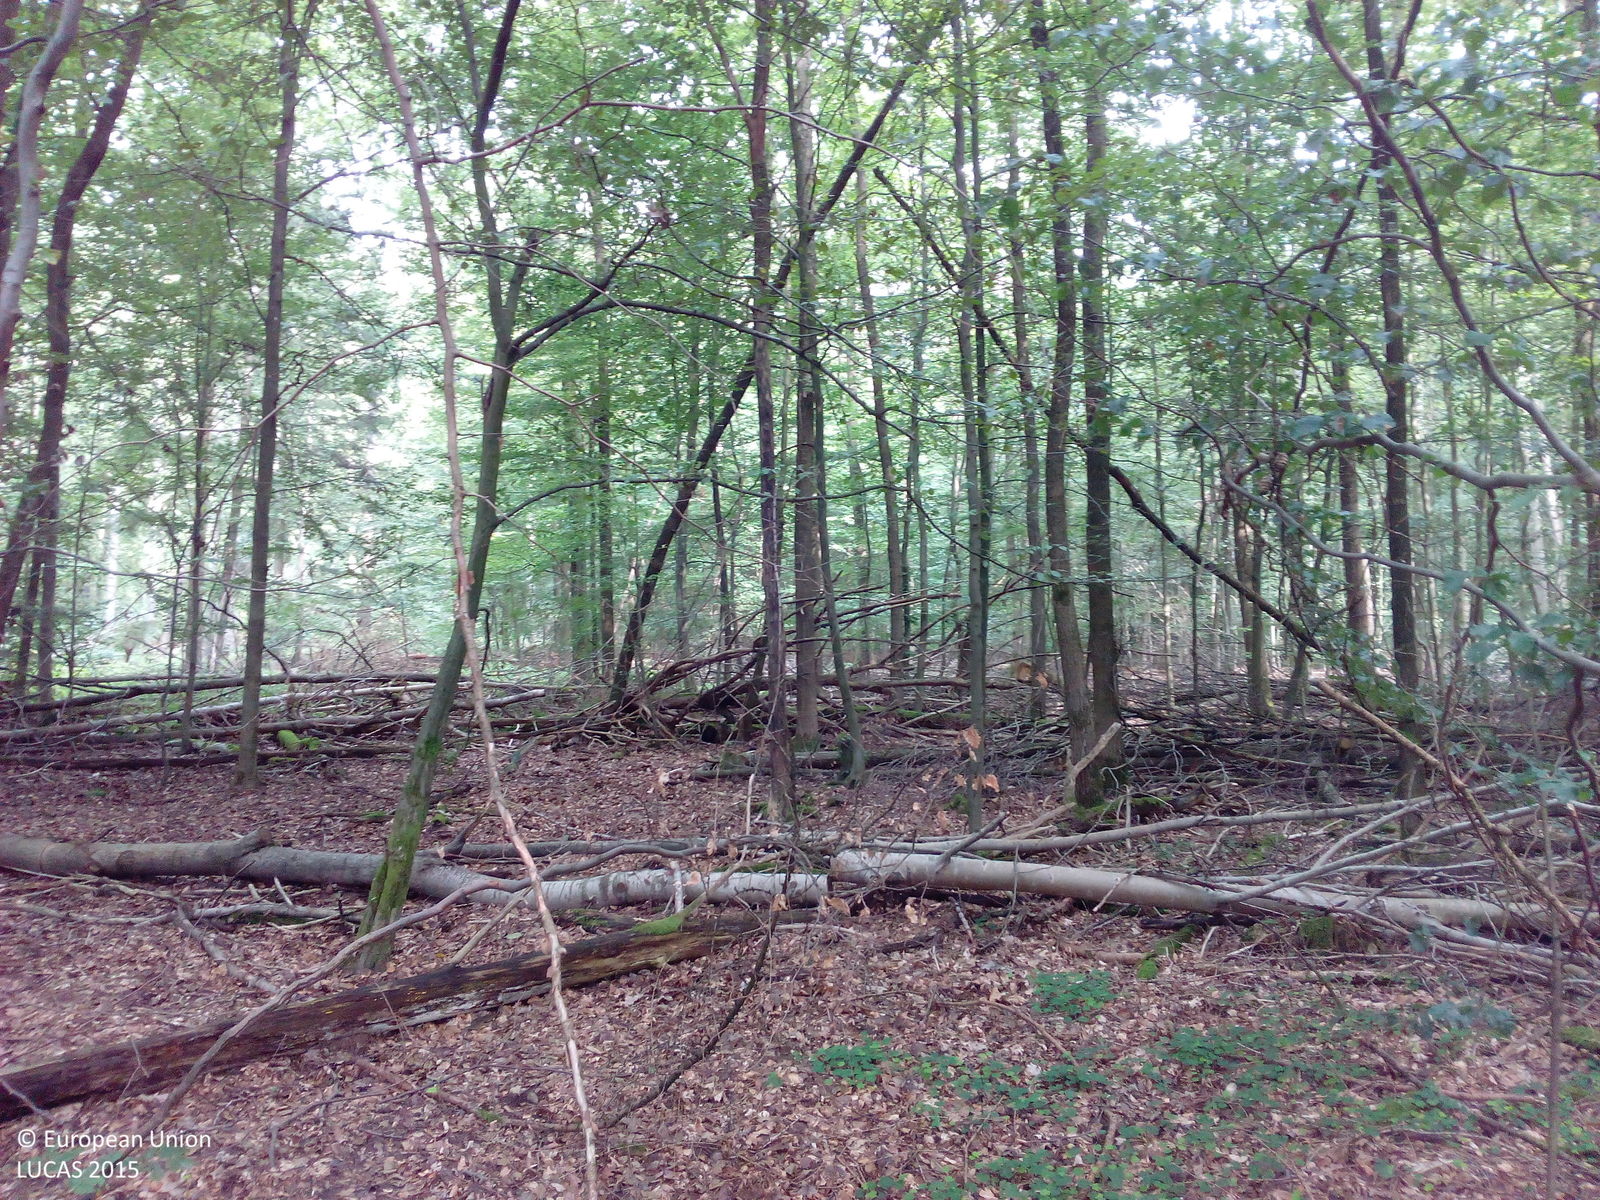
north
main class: Woodland
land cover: Spruce dominated mixed woodland
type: hemiboreal forest and nemoral coniferous forest and mixed broadleaved-coniferous forest
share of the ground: > 75 %
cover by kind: coniferous forest trees 60 %, broadleaved forest trees 40 %
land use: Forestry
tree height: > 5 m
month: September
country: DE
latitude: 51.3887
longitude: 9.8420
